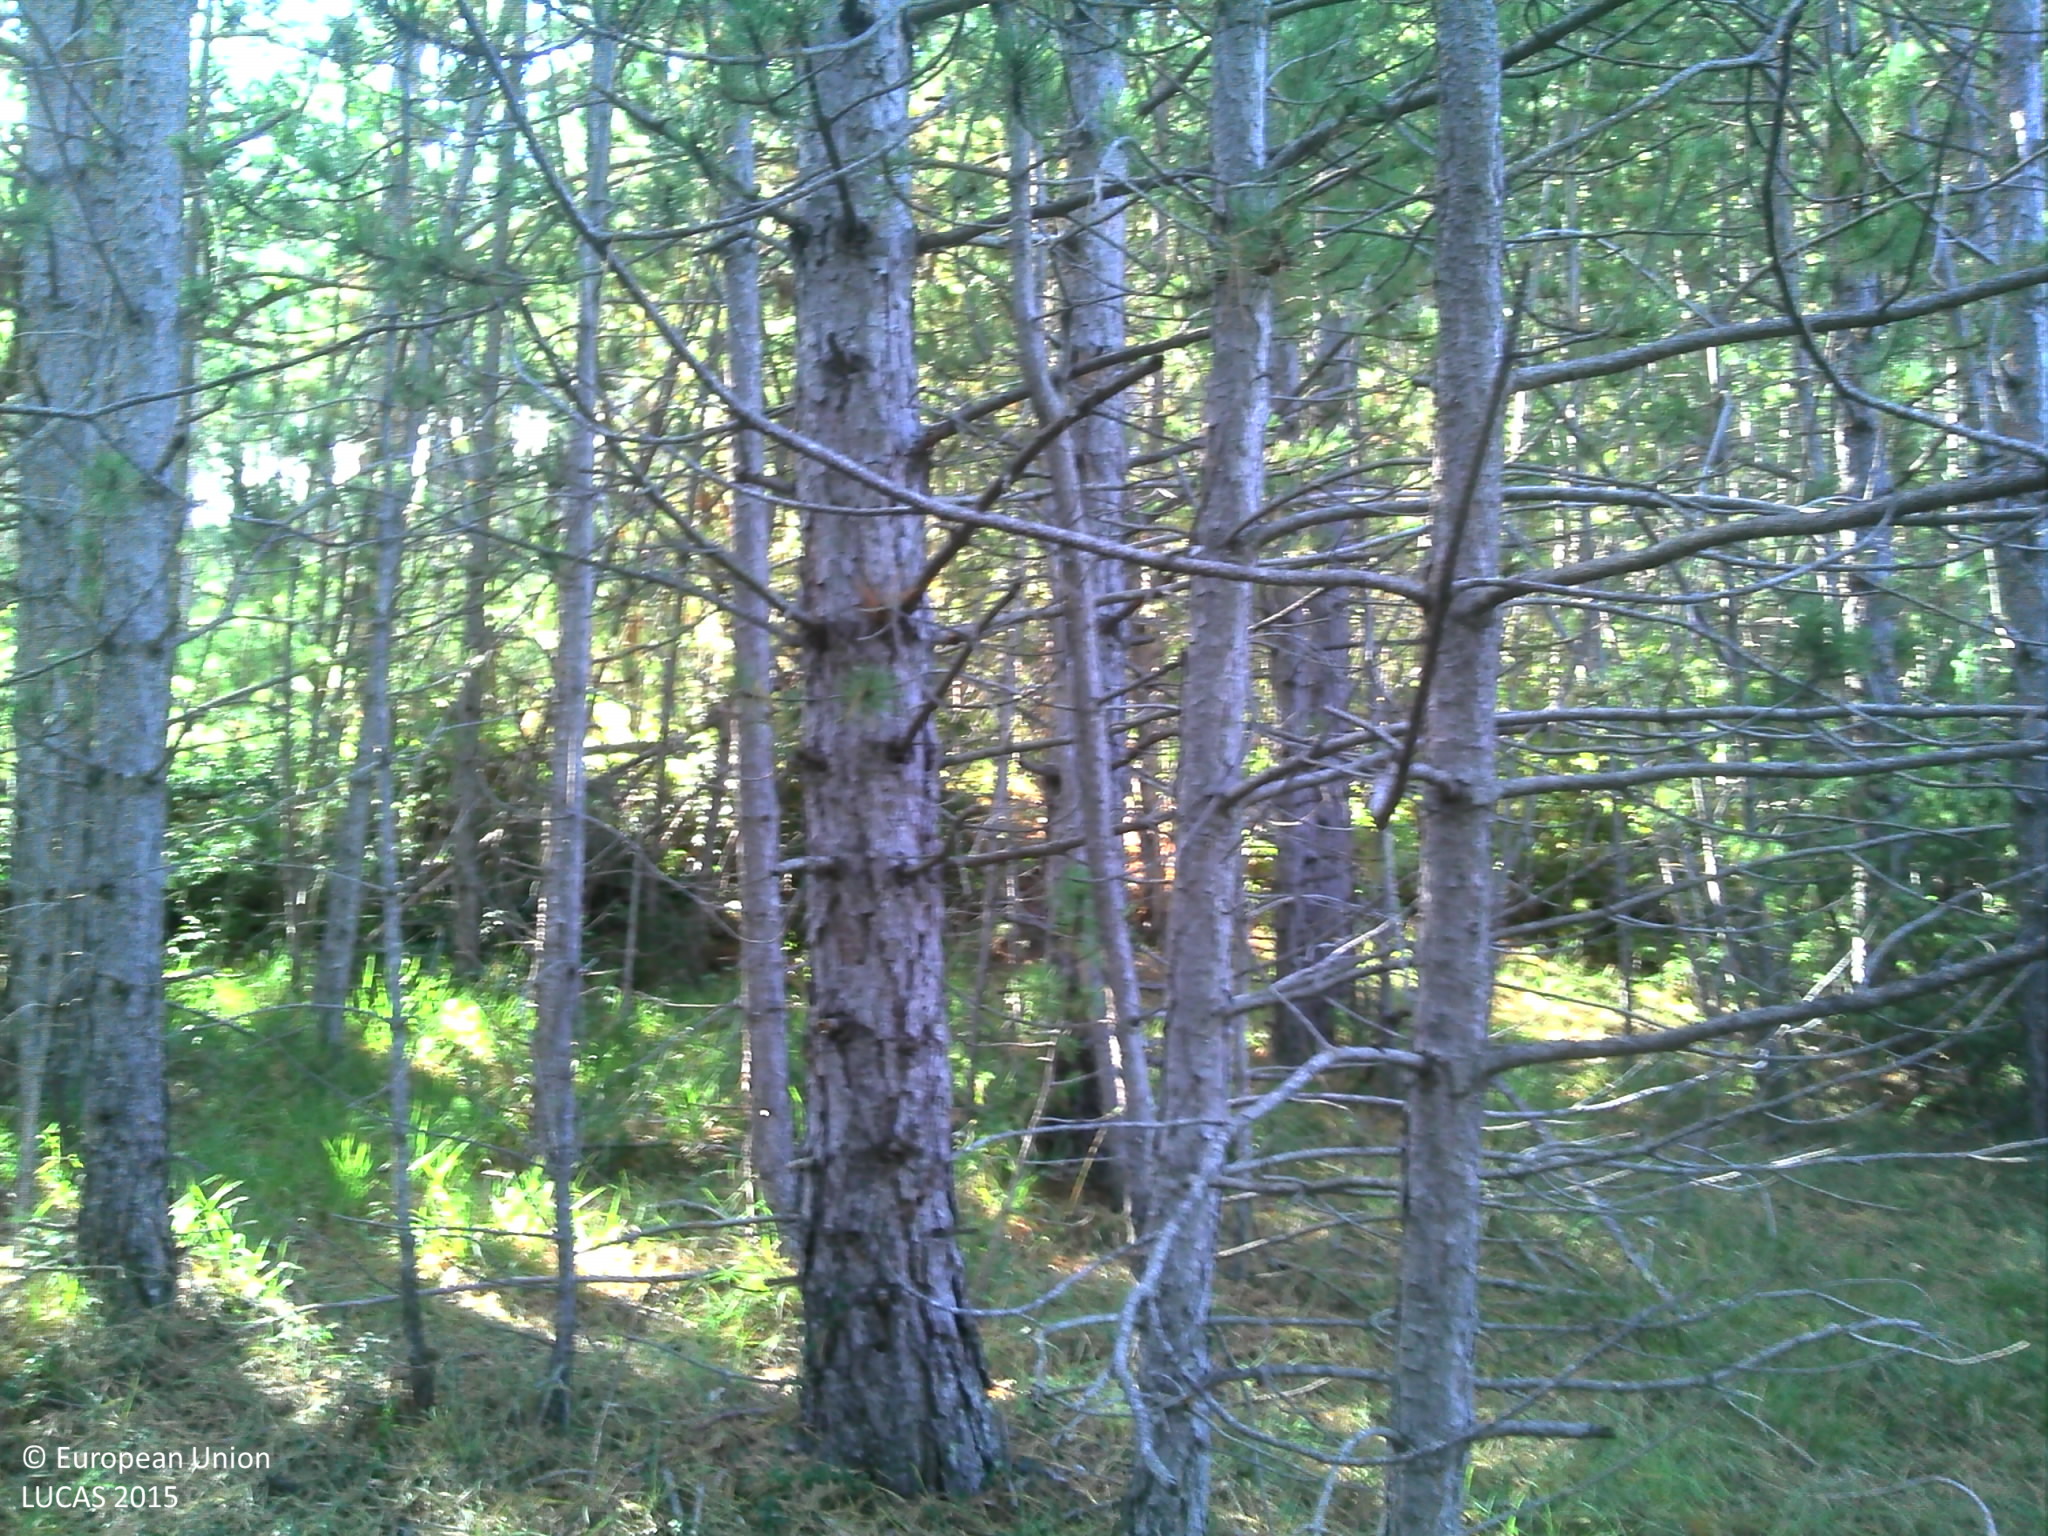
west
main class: Woodland
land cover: Pine dominated coniferous woodland
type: coniferous forest of the mediterranean region
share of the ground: > 75 %
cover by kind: coniferous forest trees 80 %, unconsolidated bare surface 15 %, broadleaved forest trees 5 %
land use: Forestry
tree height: > 5 m
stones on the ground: 10 - 25 %
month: September
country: FR
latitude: 44.2502
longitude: 5.4365
